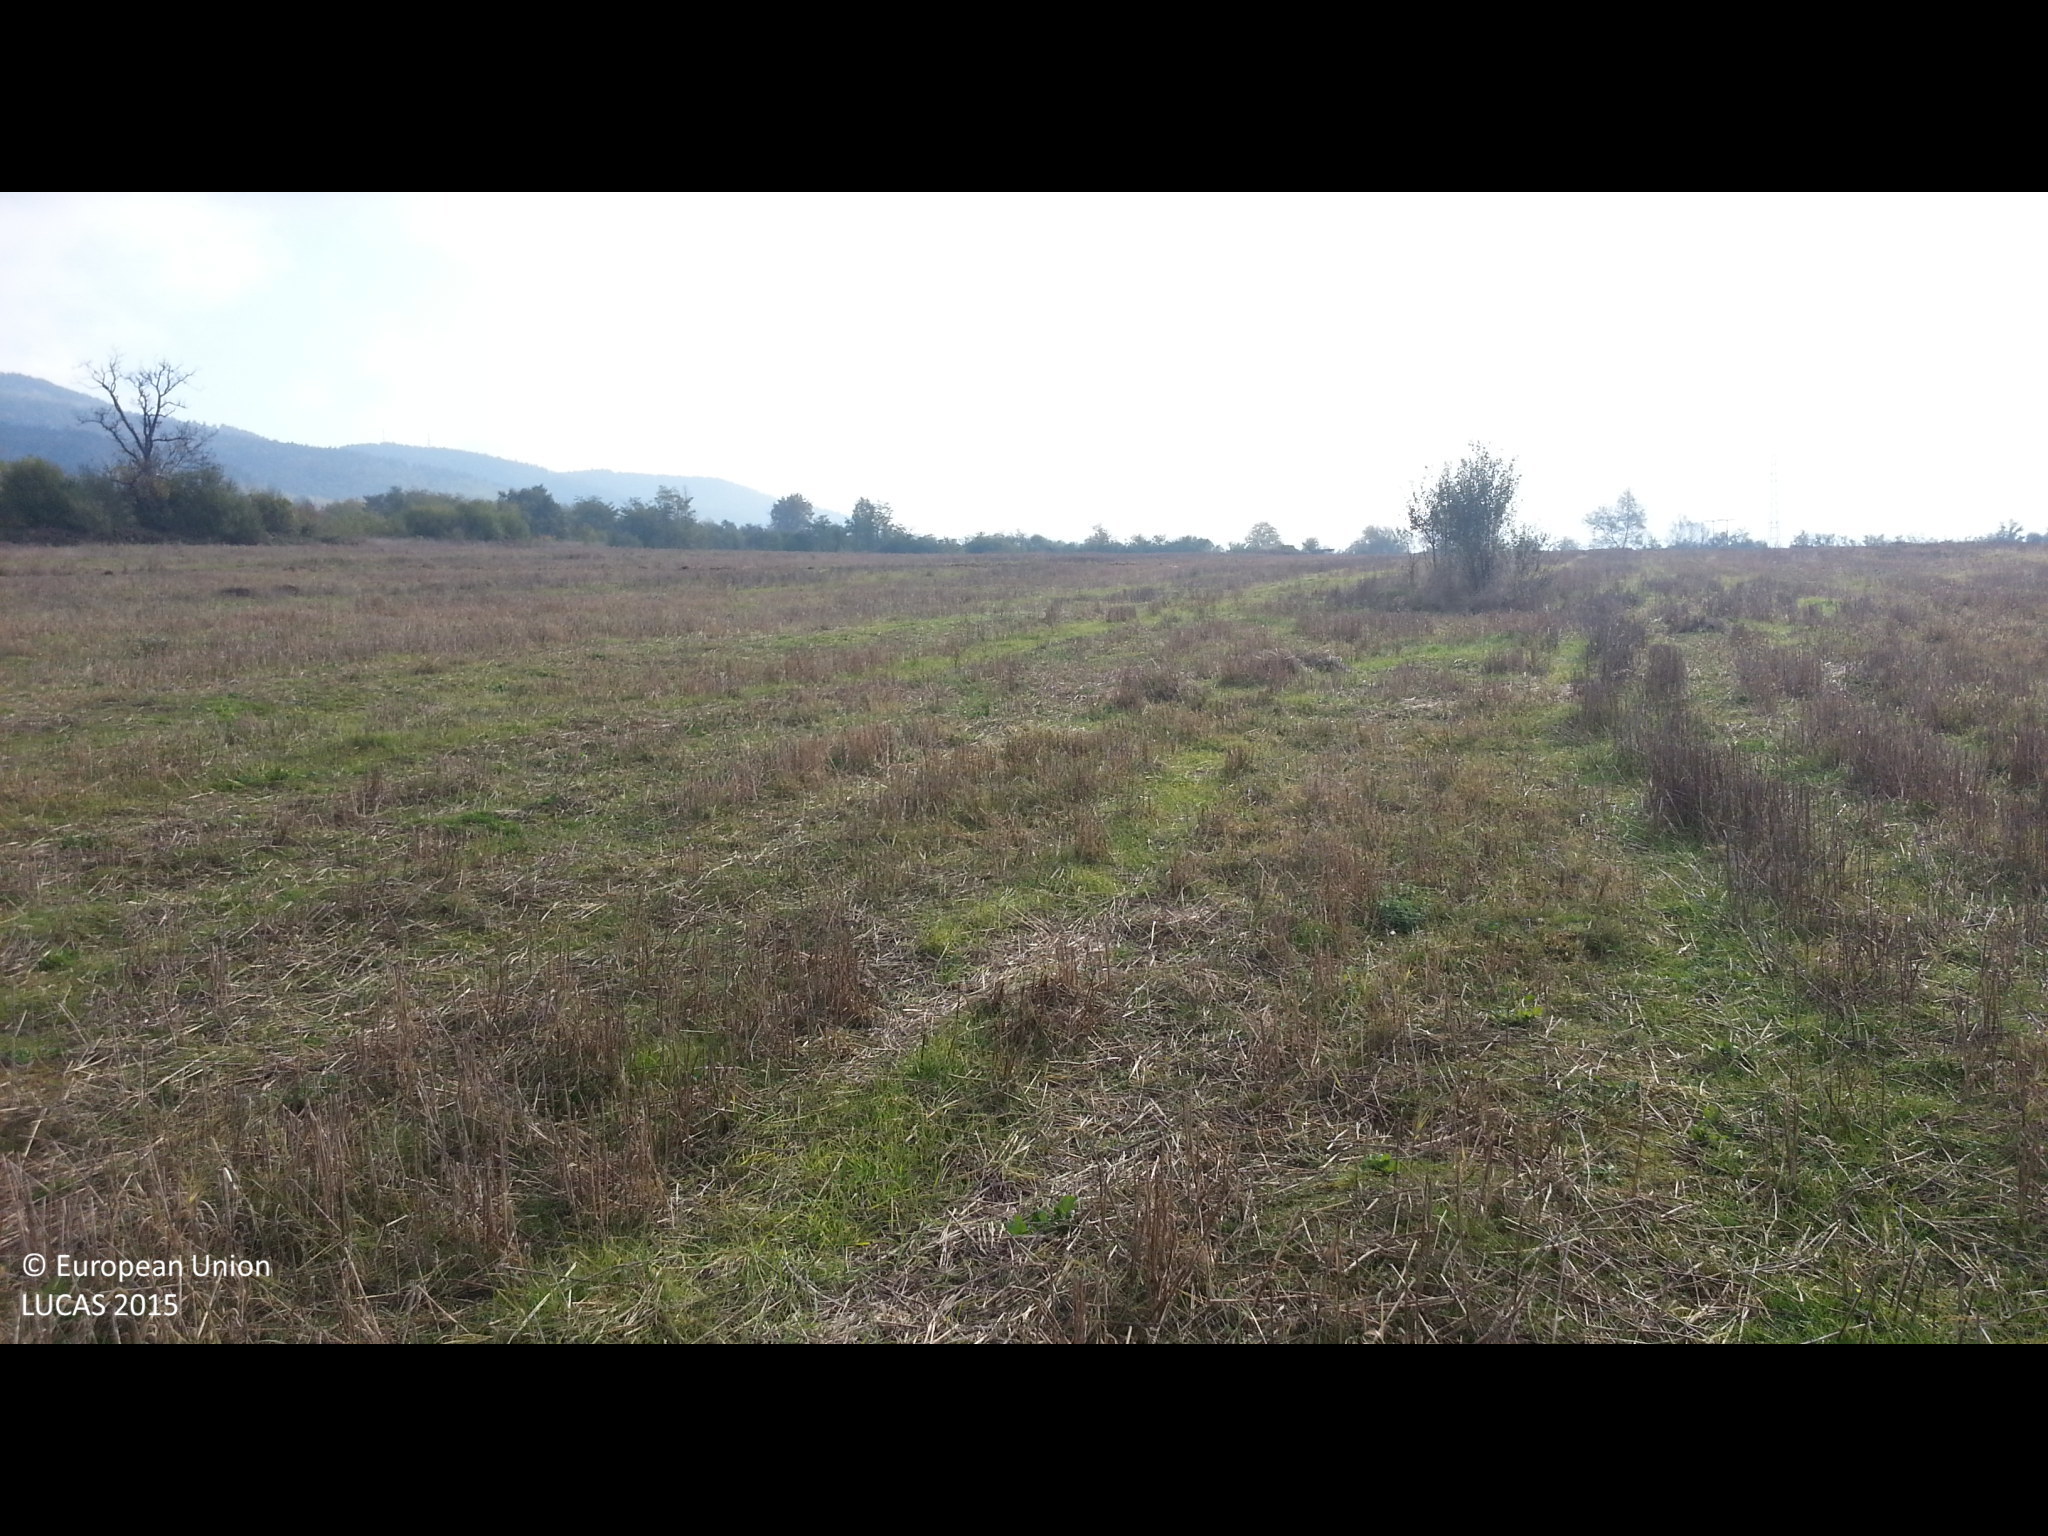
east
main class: Cropland
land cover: Common wheat
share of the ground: 10 - 25 %
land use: Agriculture (excluding fallow land and kitchen gardens)
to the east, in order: Common wheat; Grassland with sparse tree/shrub cover; Tracks; Oats
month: November
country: BG
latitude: 42.9194
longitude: 23.8760
